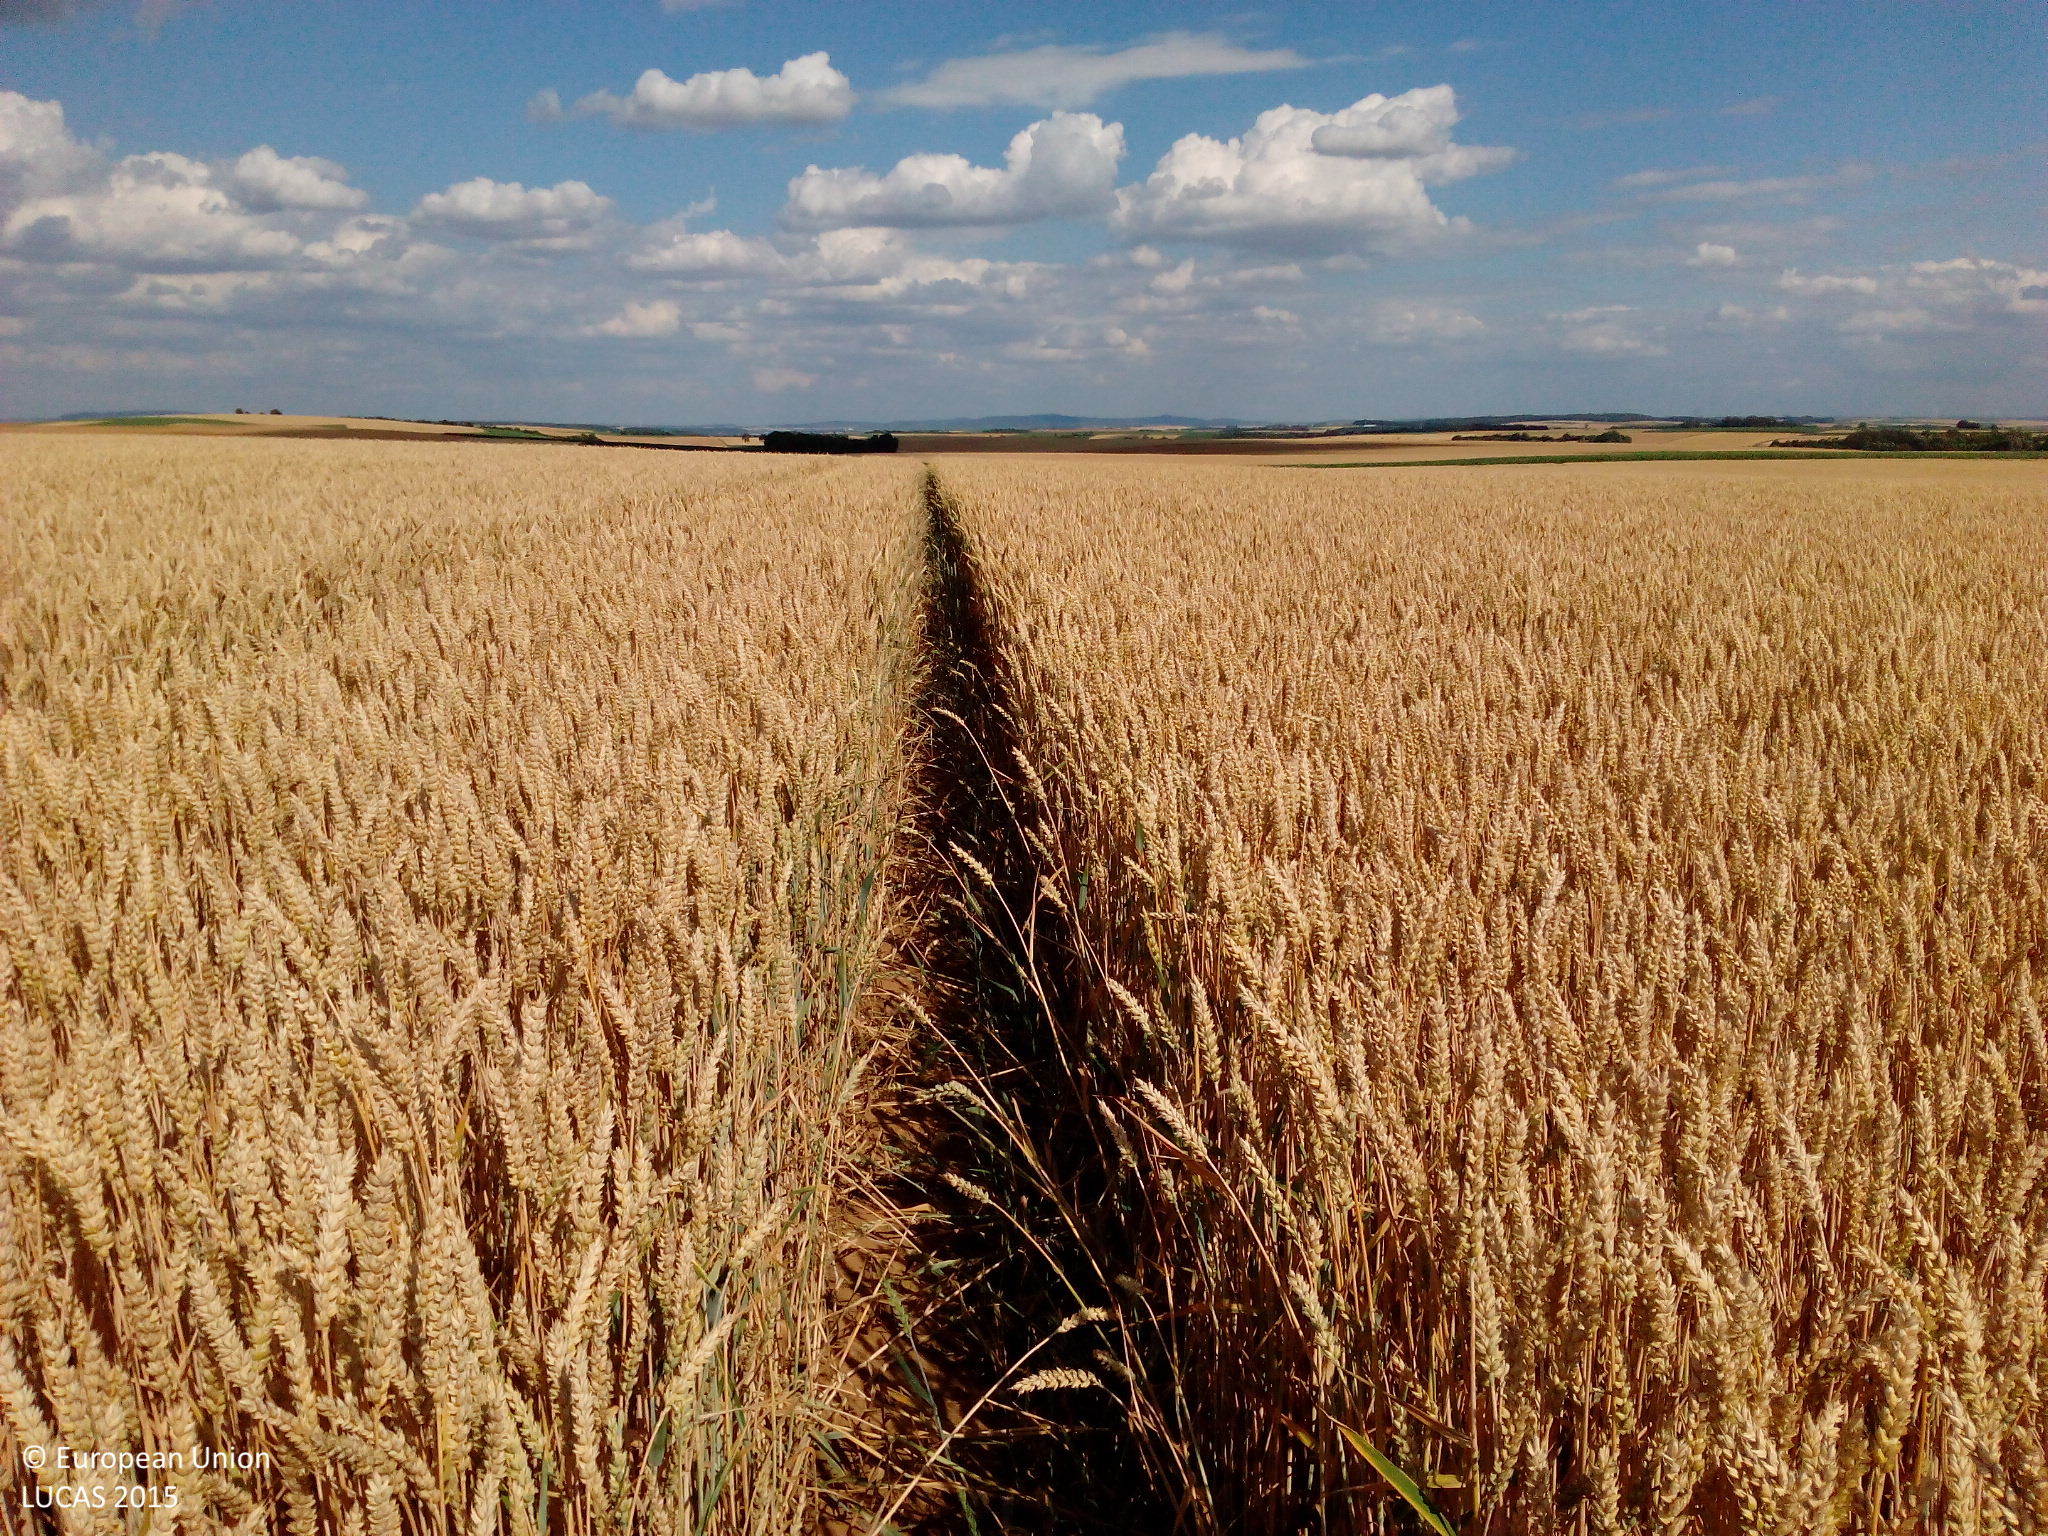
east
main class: Cropland
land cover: Common wheat
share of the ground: > 75 %
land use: Agriculture (excluding fallow land and kitchen gardens)
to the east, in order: Common wheat
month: July
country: DE
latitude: 49.6807
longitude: 9.9584
